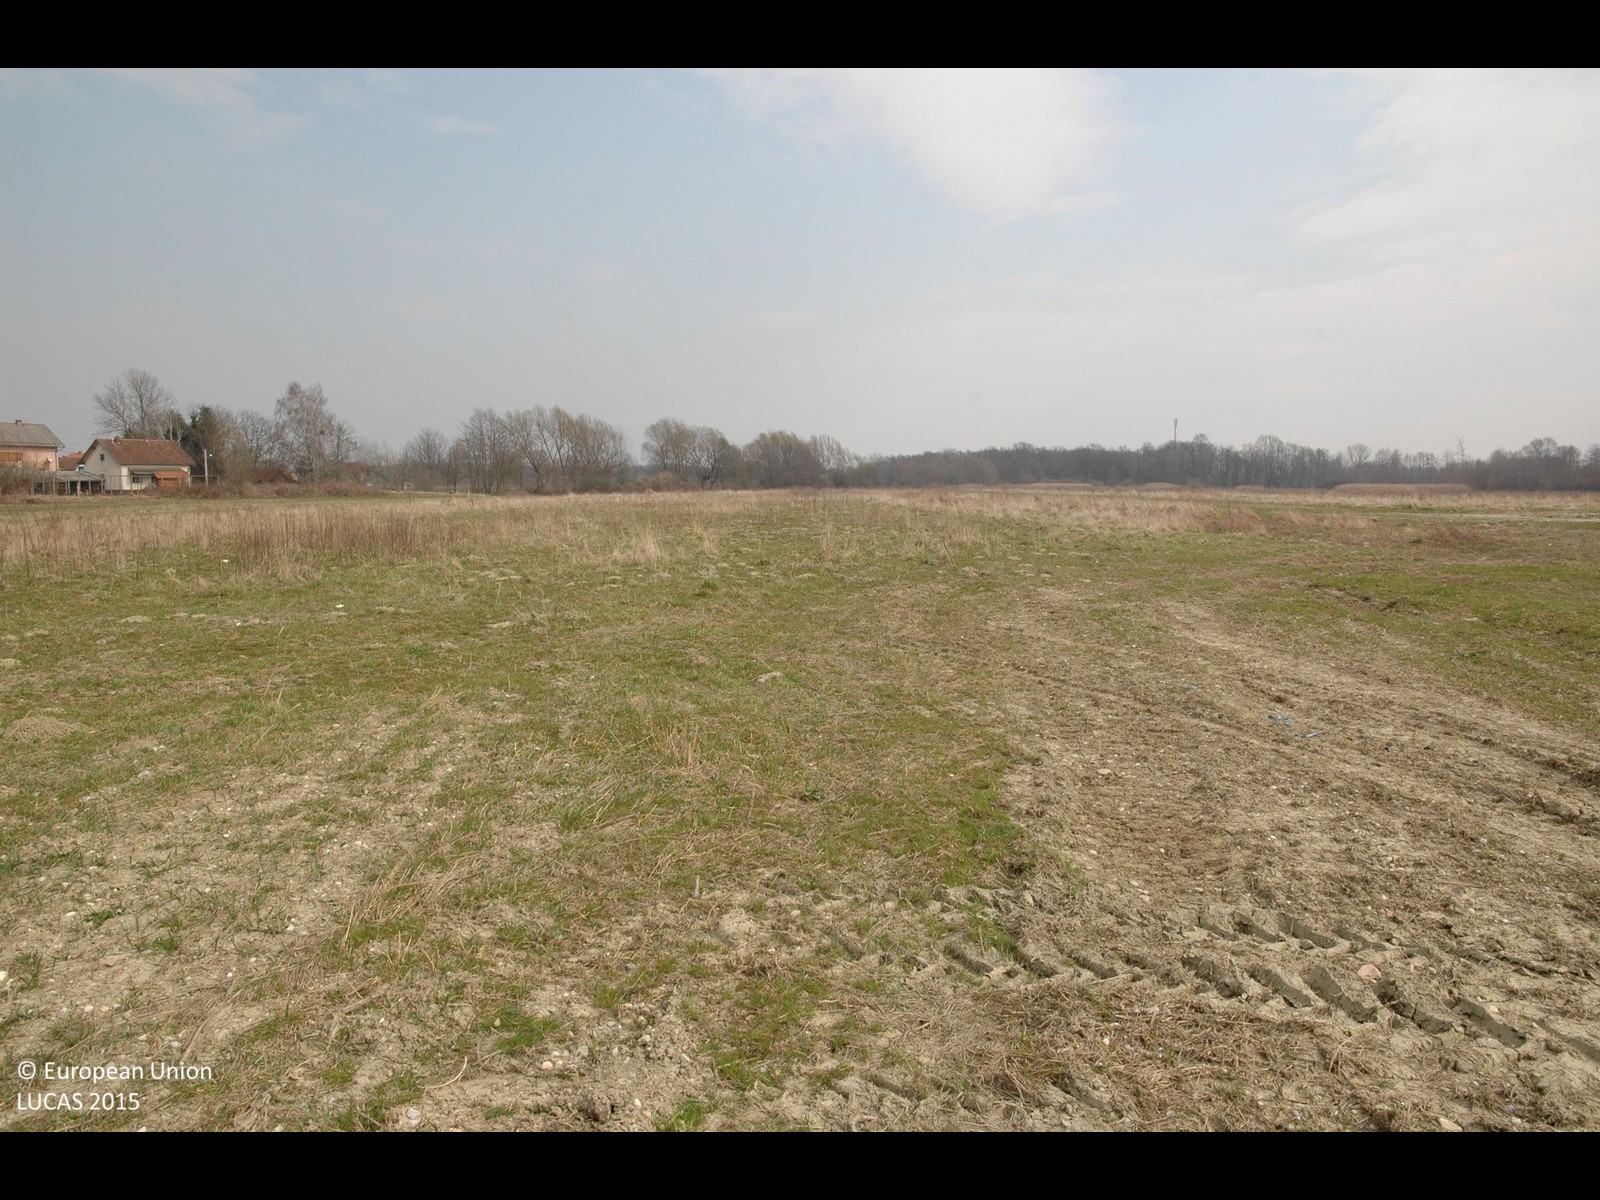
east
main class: Grassland
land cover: Spontaneously vegetated surfaces
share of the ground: > 75 %
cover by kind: herbaceous plants 100 %
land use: Agriculture (excluding fallow land and kitchen gardens)
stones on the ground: < 10 %
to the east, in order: Spontaneously vegetated surfaces; Tracks; Abandoned hedges; Rivers and streams
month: March
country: HR
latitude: 46.2860
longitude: 16.3991
